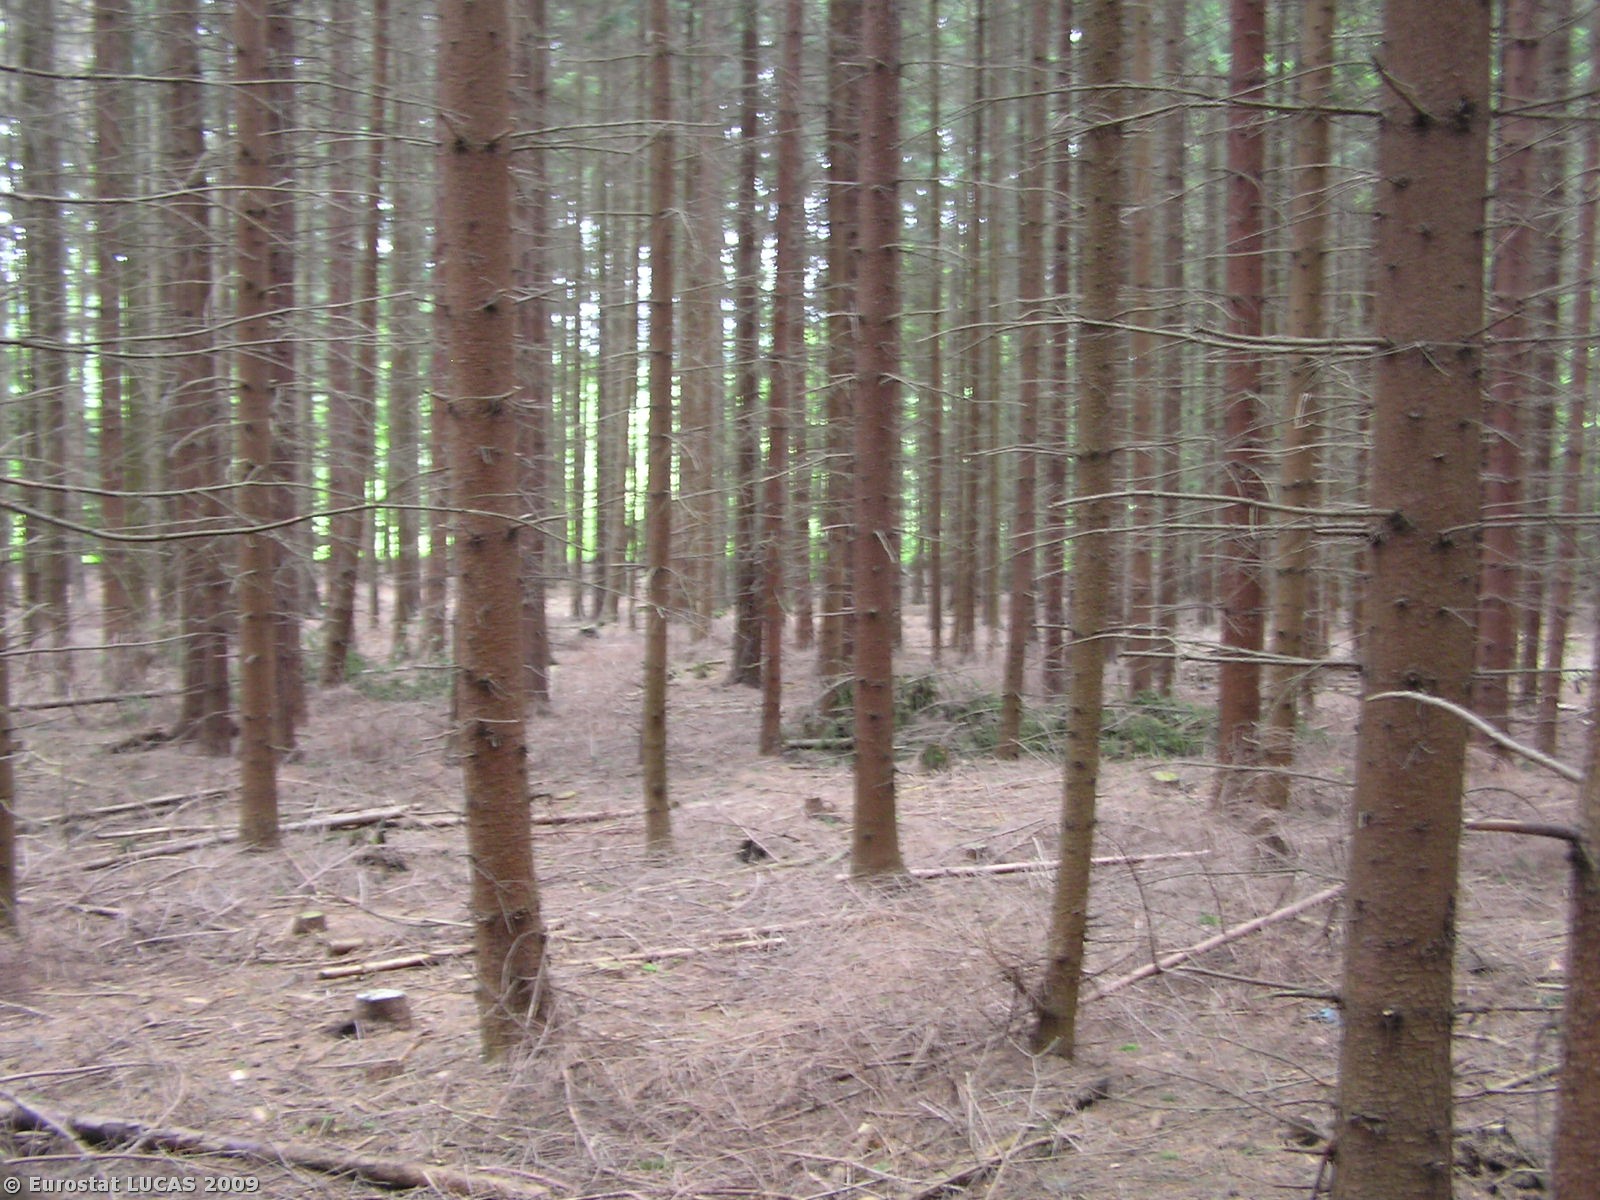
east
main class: Woodland
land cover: Coniferous woodland
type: hemiboreal forest and nemoral coniferous forest and mixed broadleaved-coniferous forest
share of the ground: > 75 %
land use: Forestry
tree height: > 5 m
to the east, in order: Coniferous woodland; Mixed woodland; Grassland with sparse tree/shrub cover; Rivers and streams; Grassland with sparse tree/shrub cover; Grassland without tree/shrub cover
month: May
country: CZ
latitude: 49.3192
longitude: 14.9686
